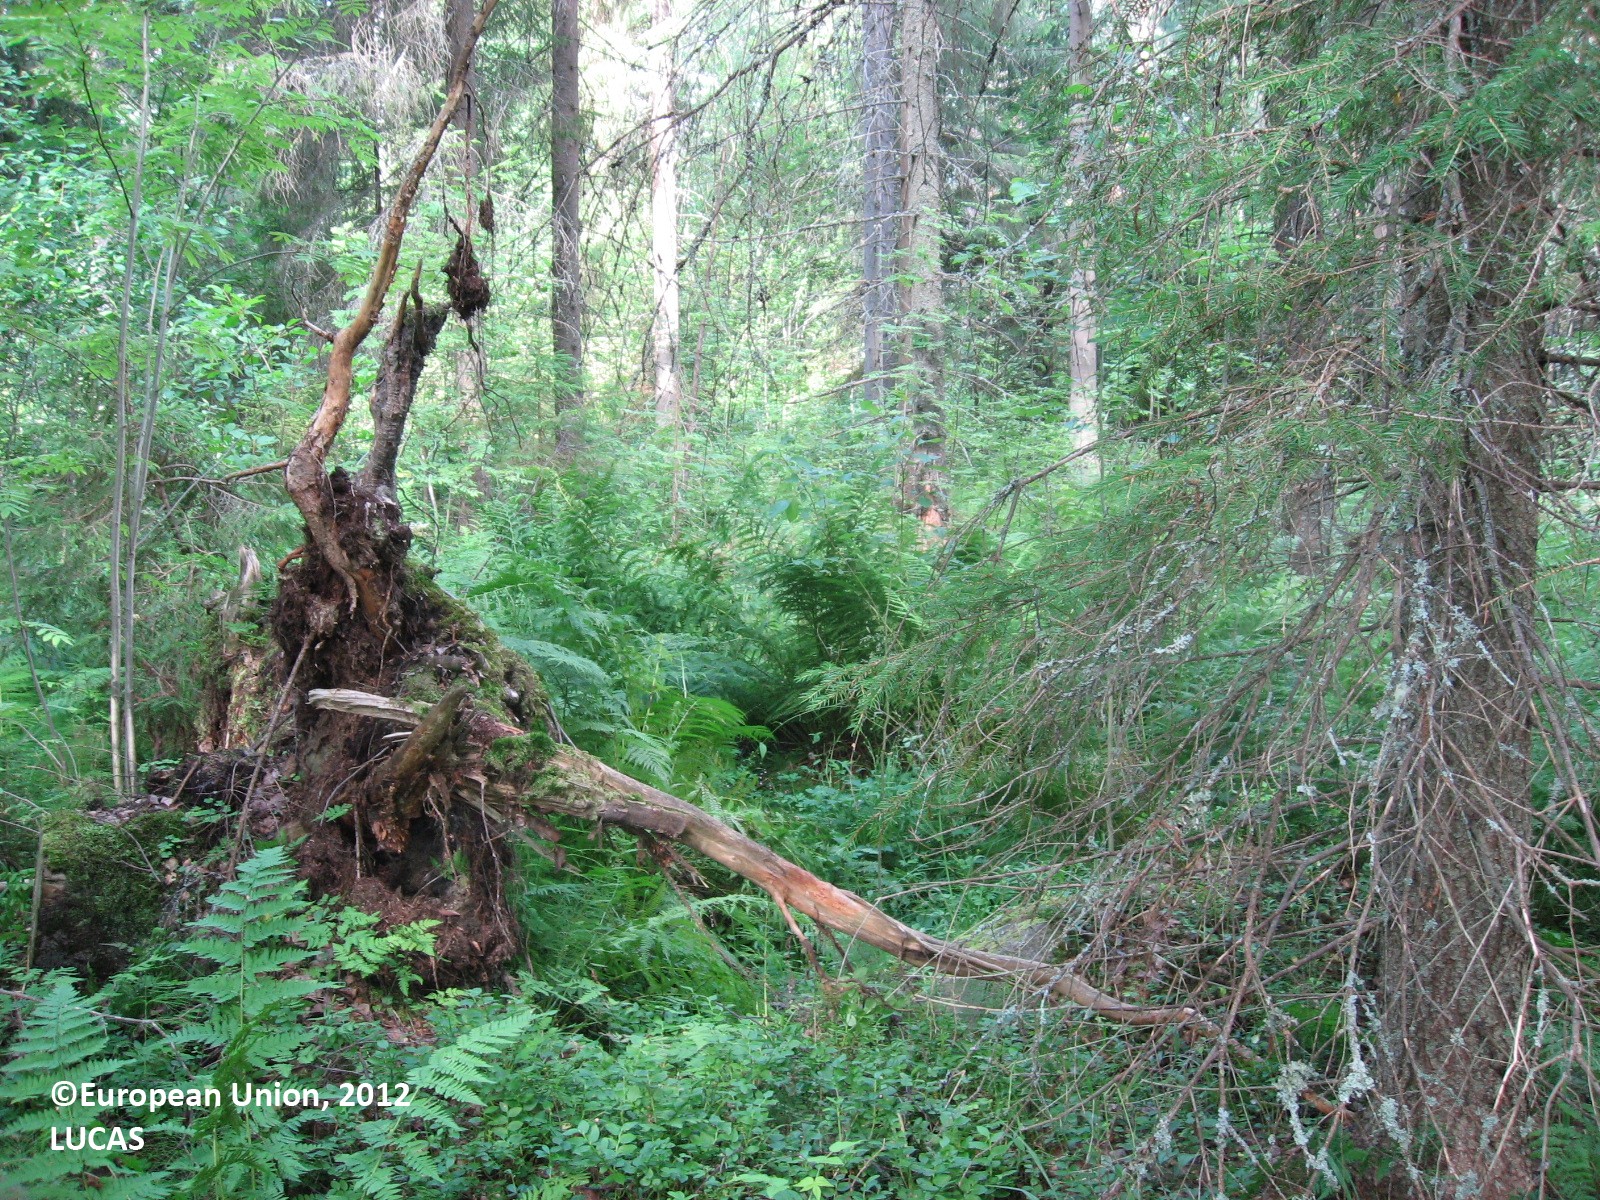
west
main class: Woodland
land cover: Spruce dominated mixed woodland
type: boreal forest
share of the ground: 50 - 75 %
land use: Forestry
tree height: > 5 m
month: July
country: FI
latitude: 61.2611
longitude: 25.3899
